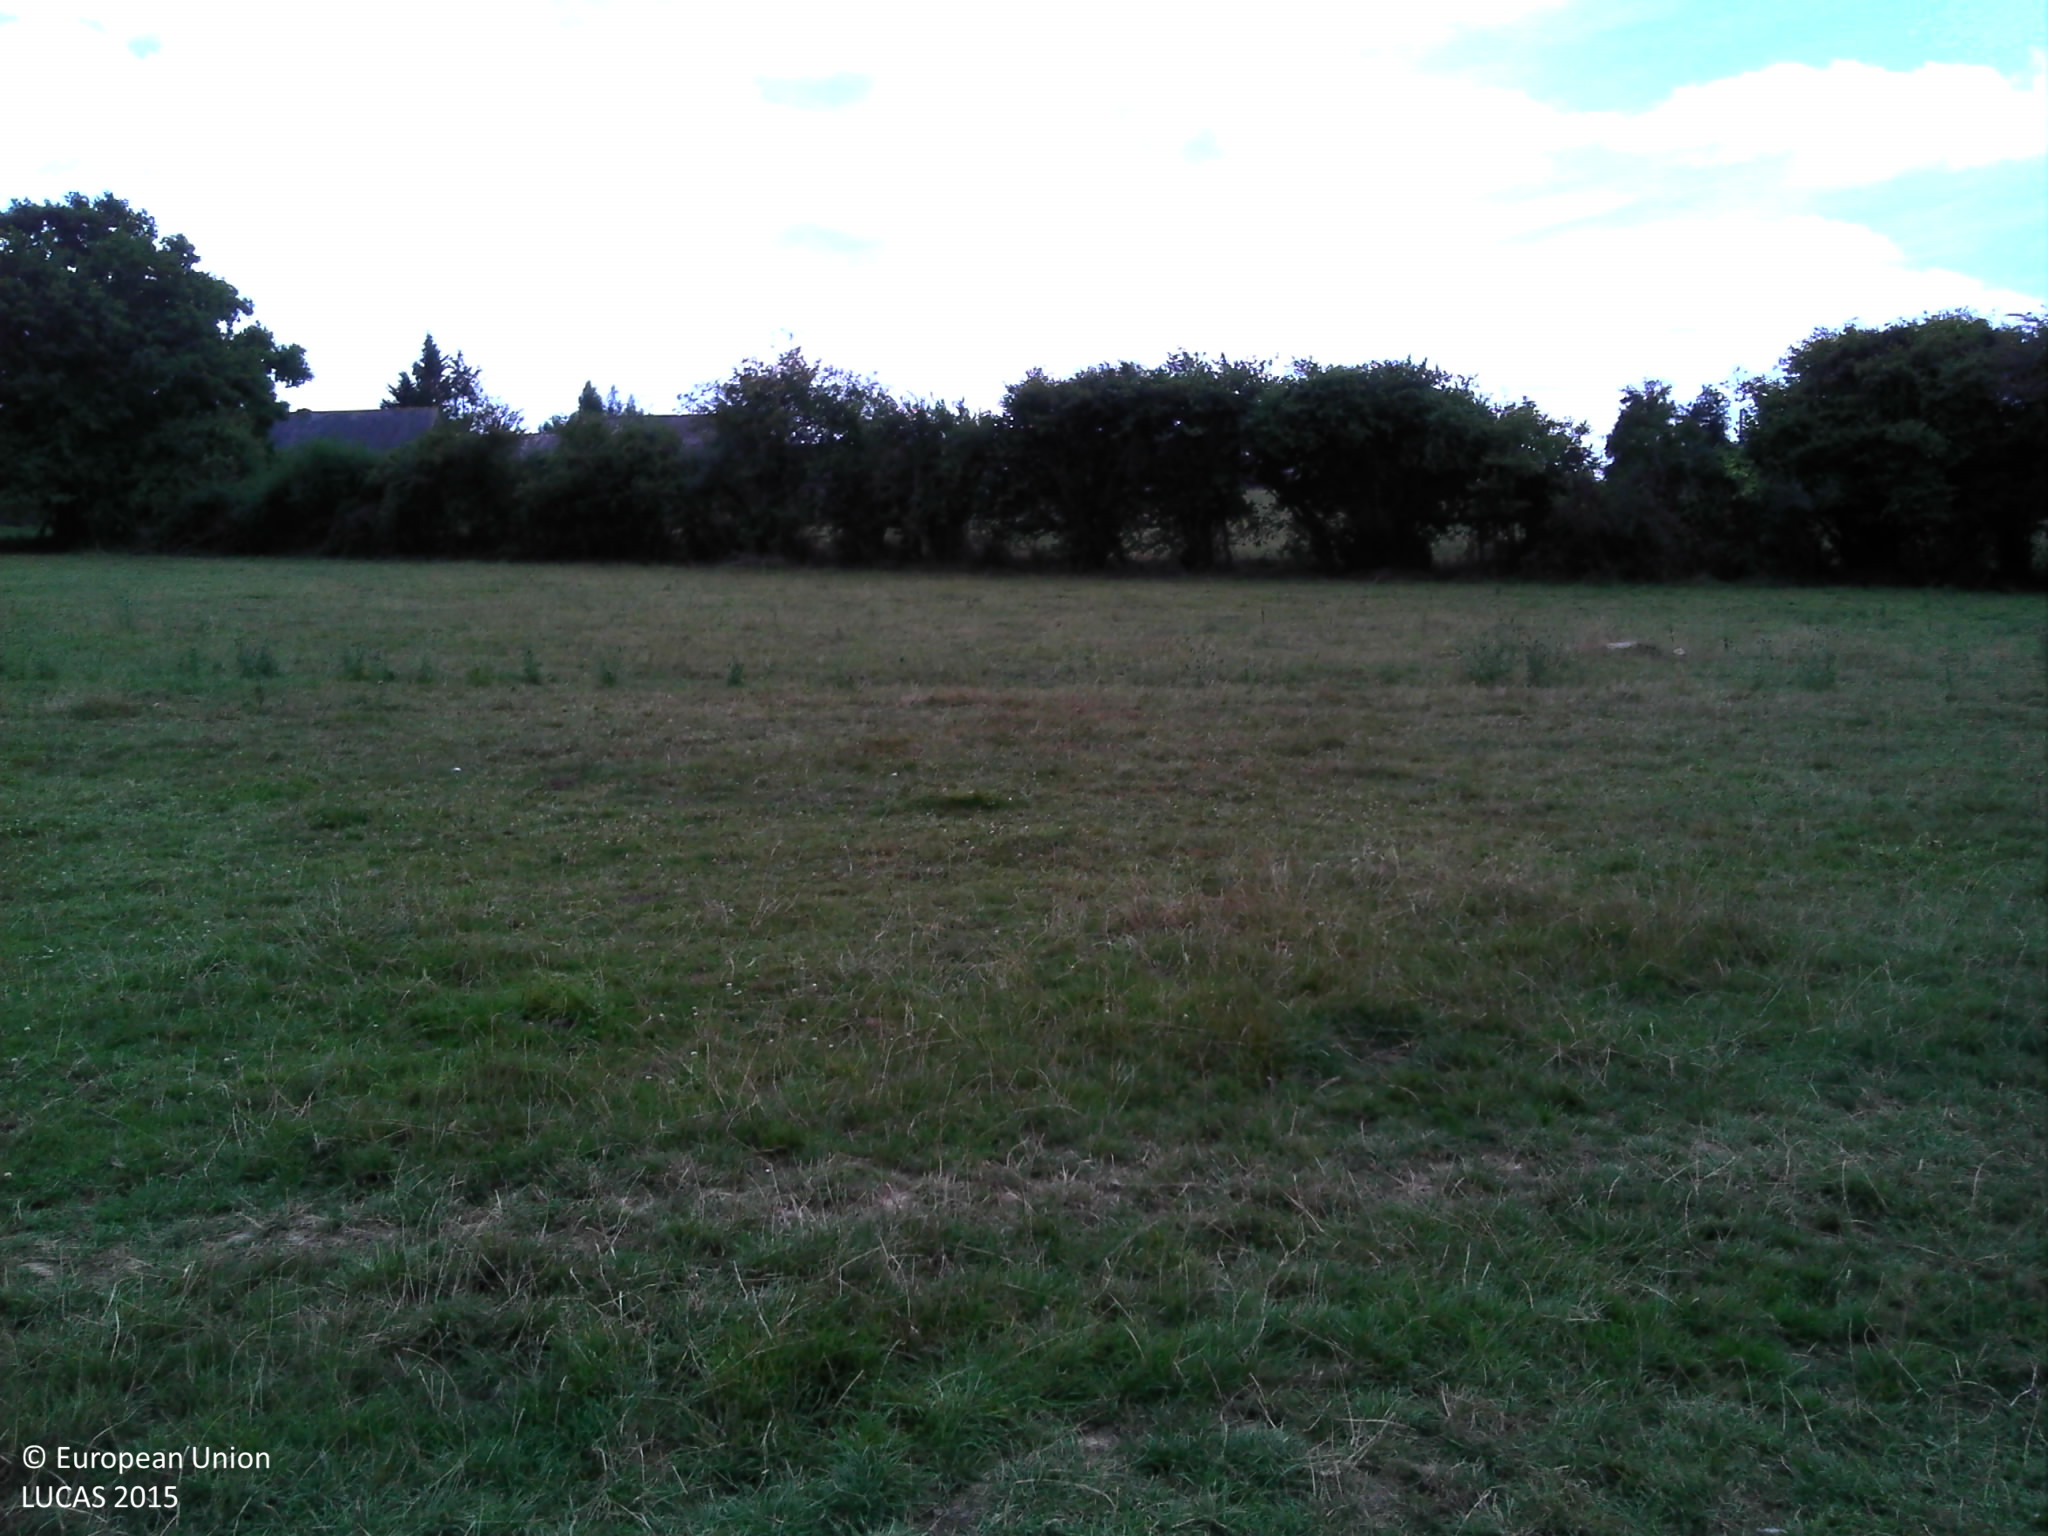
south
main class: Grassland
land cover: Grassland without tree/shrub cover
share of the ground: > 75 %
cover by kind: herbaceous plants 100 %
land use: Agriculture (excluding fallow land and kitchen gardens)
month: August
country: FR
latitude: 47.7427
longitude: -1.3650
